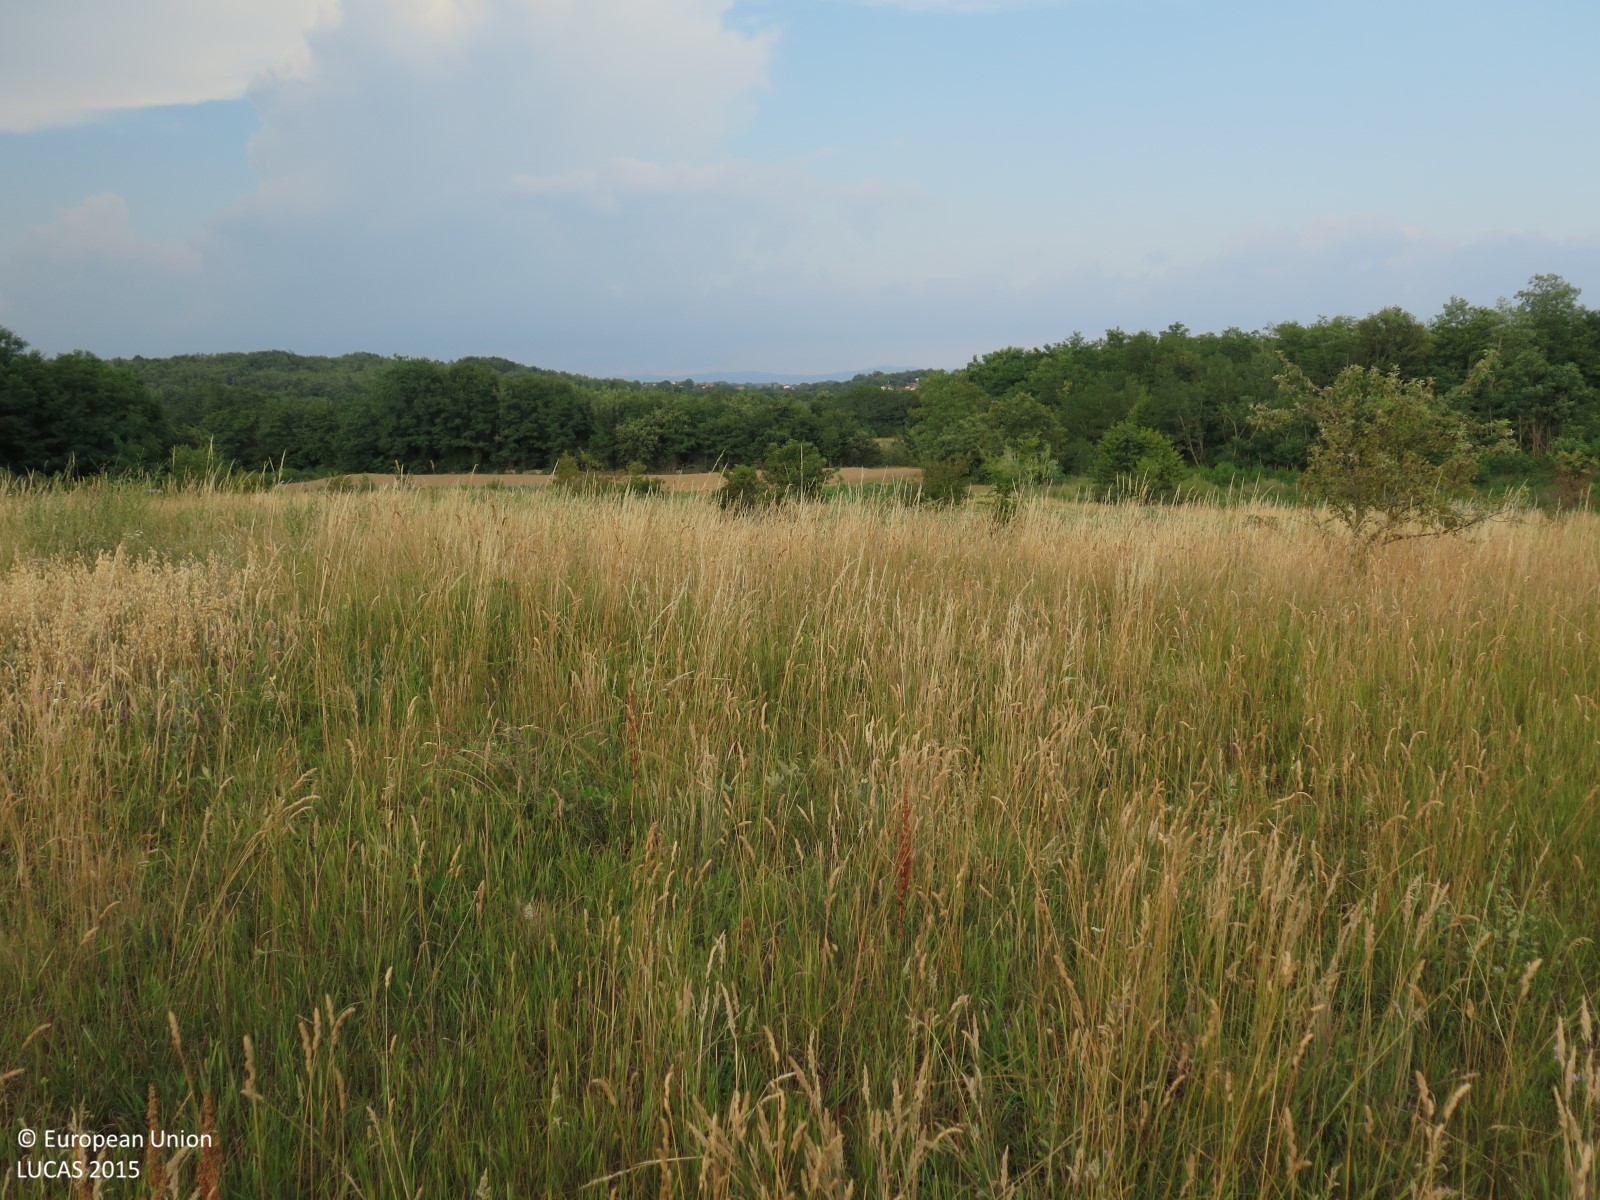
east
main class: Grassland
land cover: Grassland without tree/shrub cover
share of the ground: > 75 %
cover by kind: herbaceous plants 100 %
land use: Agriculture (excluding fallow land and kitchen gardens)
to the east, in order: Grassland without tree/shrub cover; Tracks; Grassland without tree/shrub cover; Tracks; Grassland without tree/shrub cover; Potatoes; Shrubland without tree cover; Broadleaved woodland; Dry stone walls; Broadleaved woodland
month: July
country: HR
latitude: 45.2545
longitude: 13.8303
